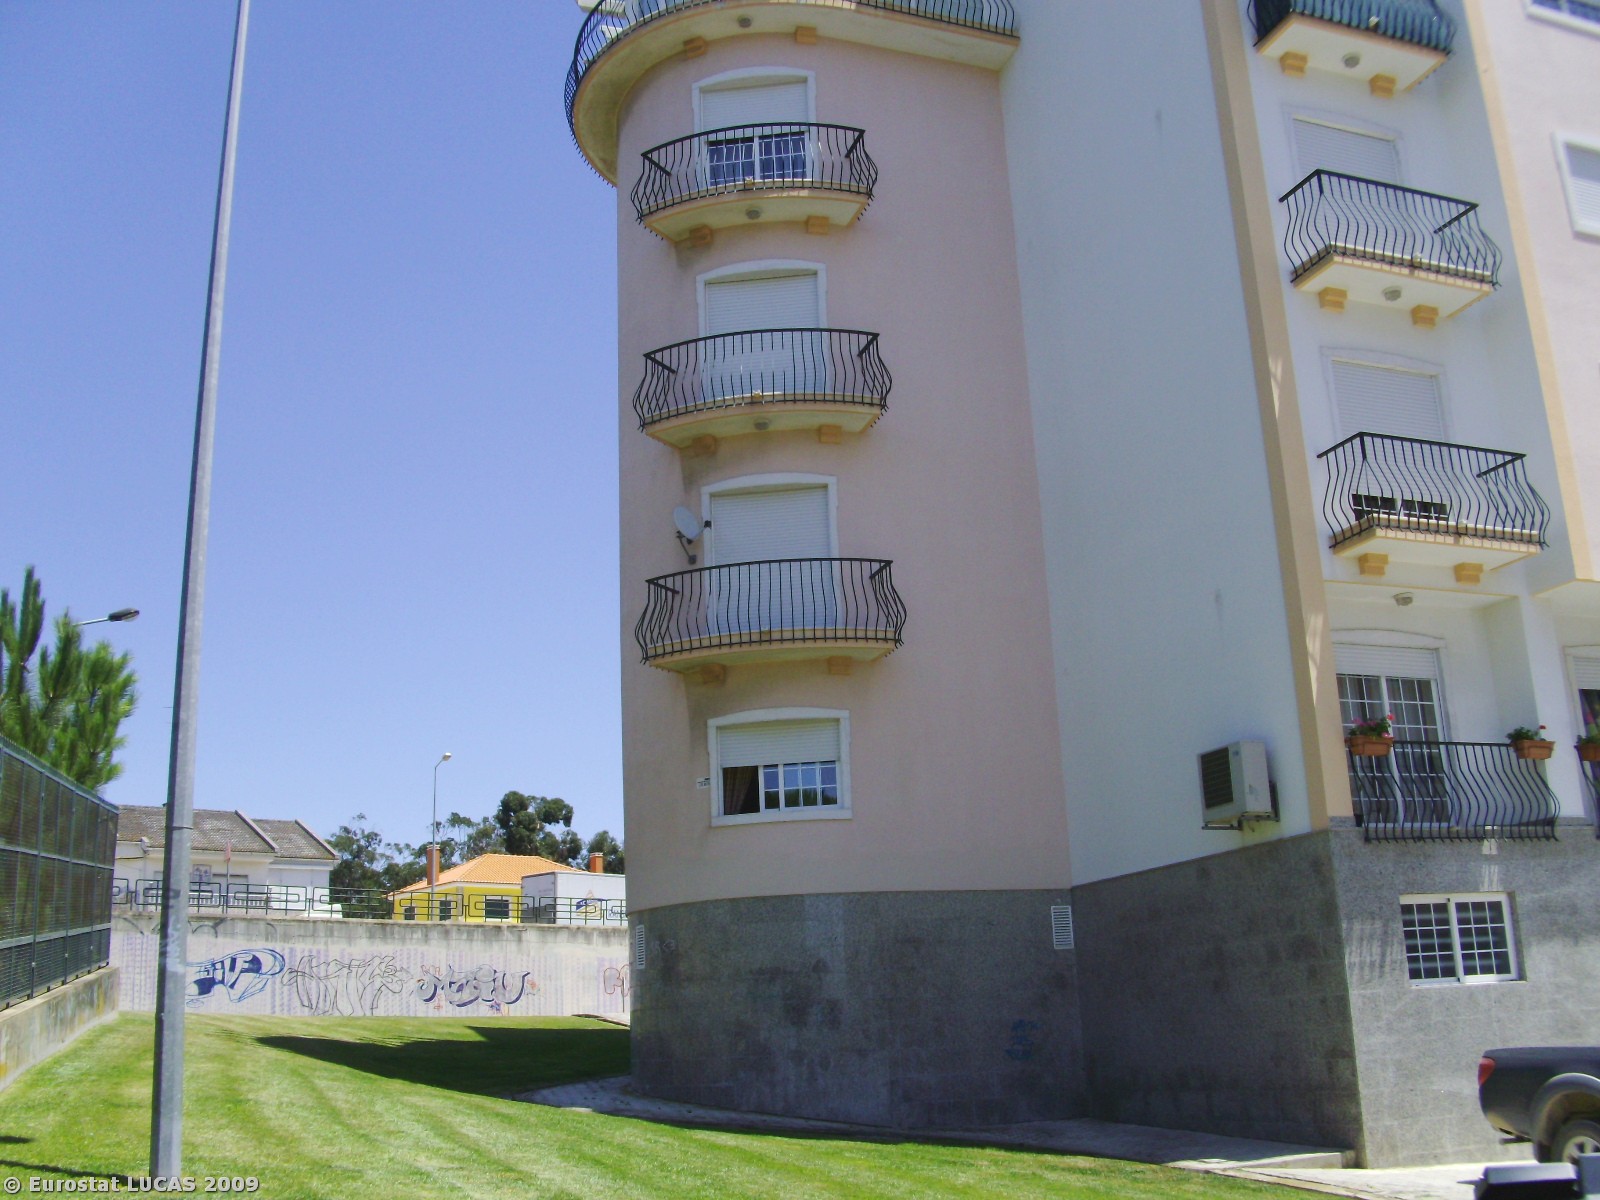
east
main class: Woodland
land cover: Coniferous woodland
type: coniferous forest of the mediterranean region
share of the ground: 25 - 50 %
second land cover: Shrubland with sparse tree cover
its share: 50 - 75 %
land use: Forestry
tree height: > 5 m
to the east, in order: Coniferous woodland; Shrubland with sparse tree cover; Coniferous woodland; Fences; Artificial constructions in urban areas; Spontaneously vegetated surfaces; Tracks; Electric lines; Bare land
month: July
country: PT
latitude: 38.6247
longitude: -9.1285
